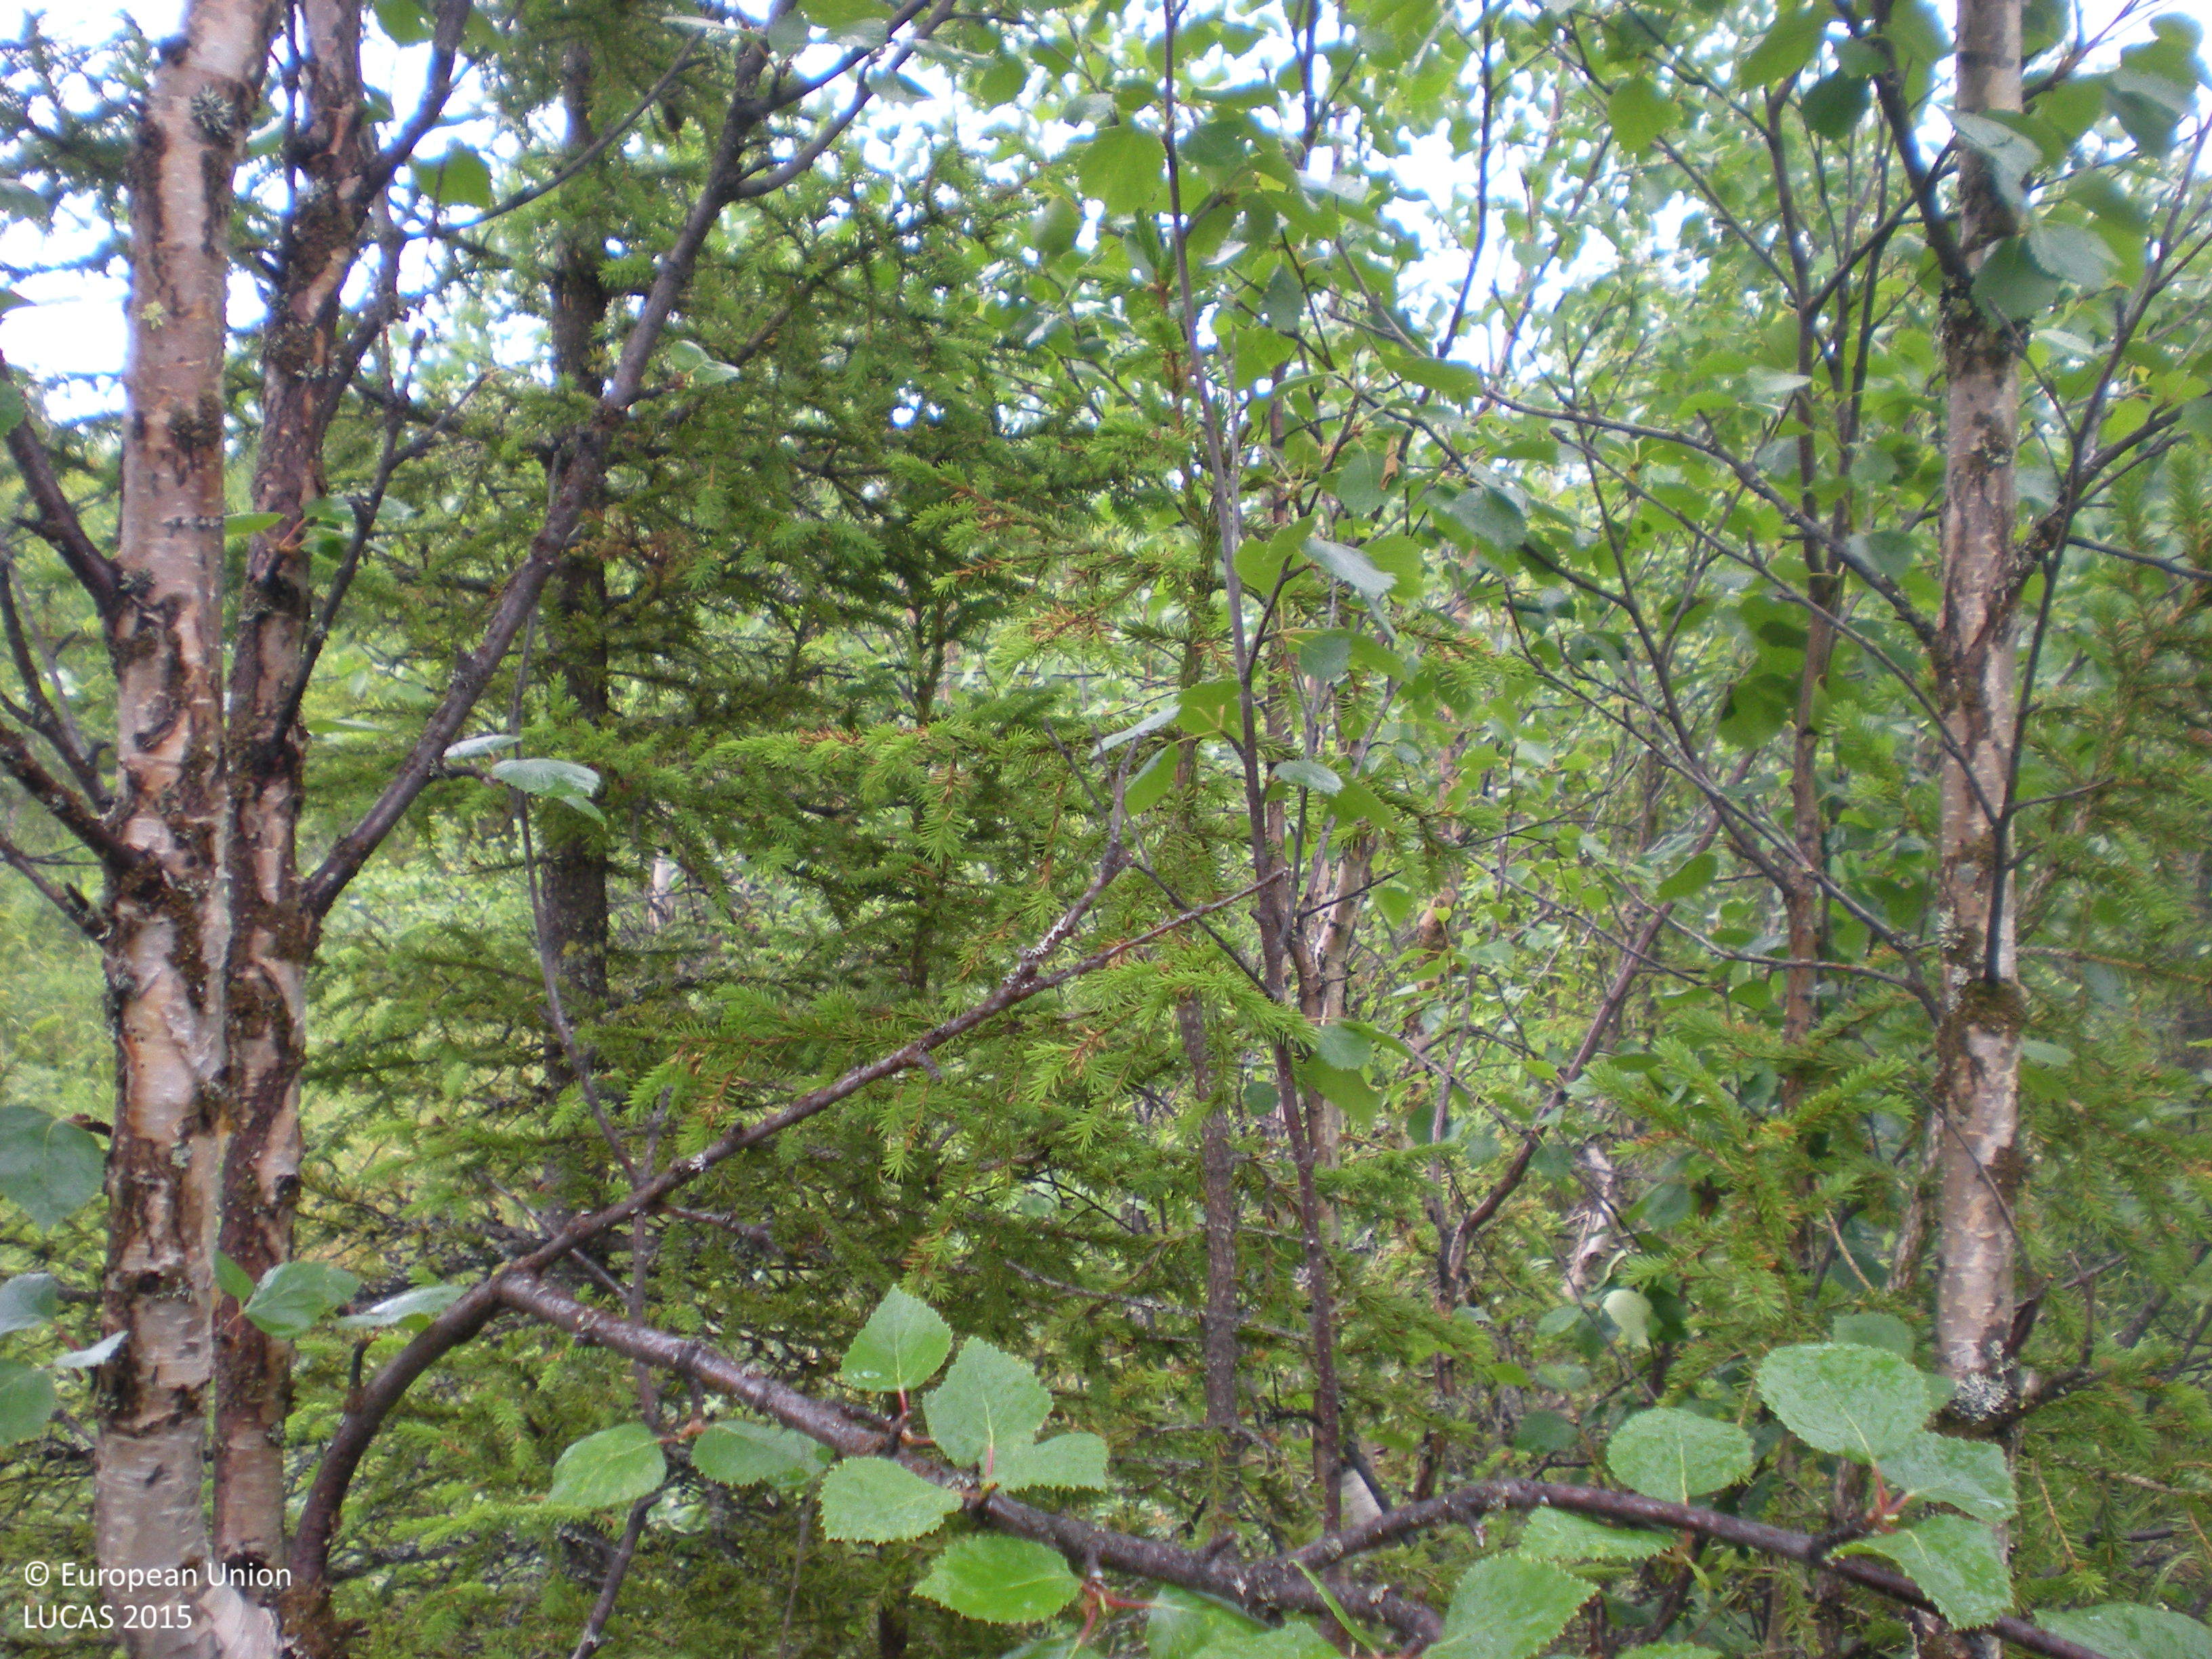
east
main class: Woodland
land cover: Spruce dominated mixed woodland
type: boreal forest
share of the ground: 50 - 75 %
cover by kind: broadleaved forest trees 55 %, coniferous forest trees 20 %, herbaceous plants 10 %, lichens and mosses 10 %, shrubs 5 %
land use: Forestry
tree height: > 5 m
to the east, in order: Spruce dominated mixed woodland; Pine dominated mixed woodland
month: July
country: SE
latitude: 65.7765
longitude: 17.2315
